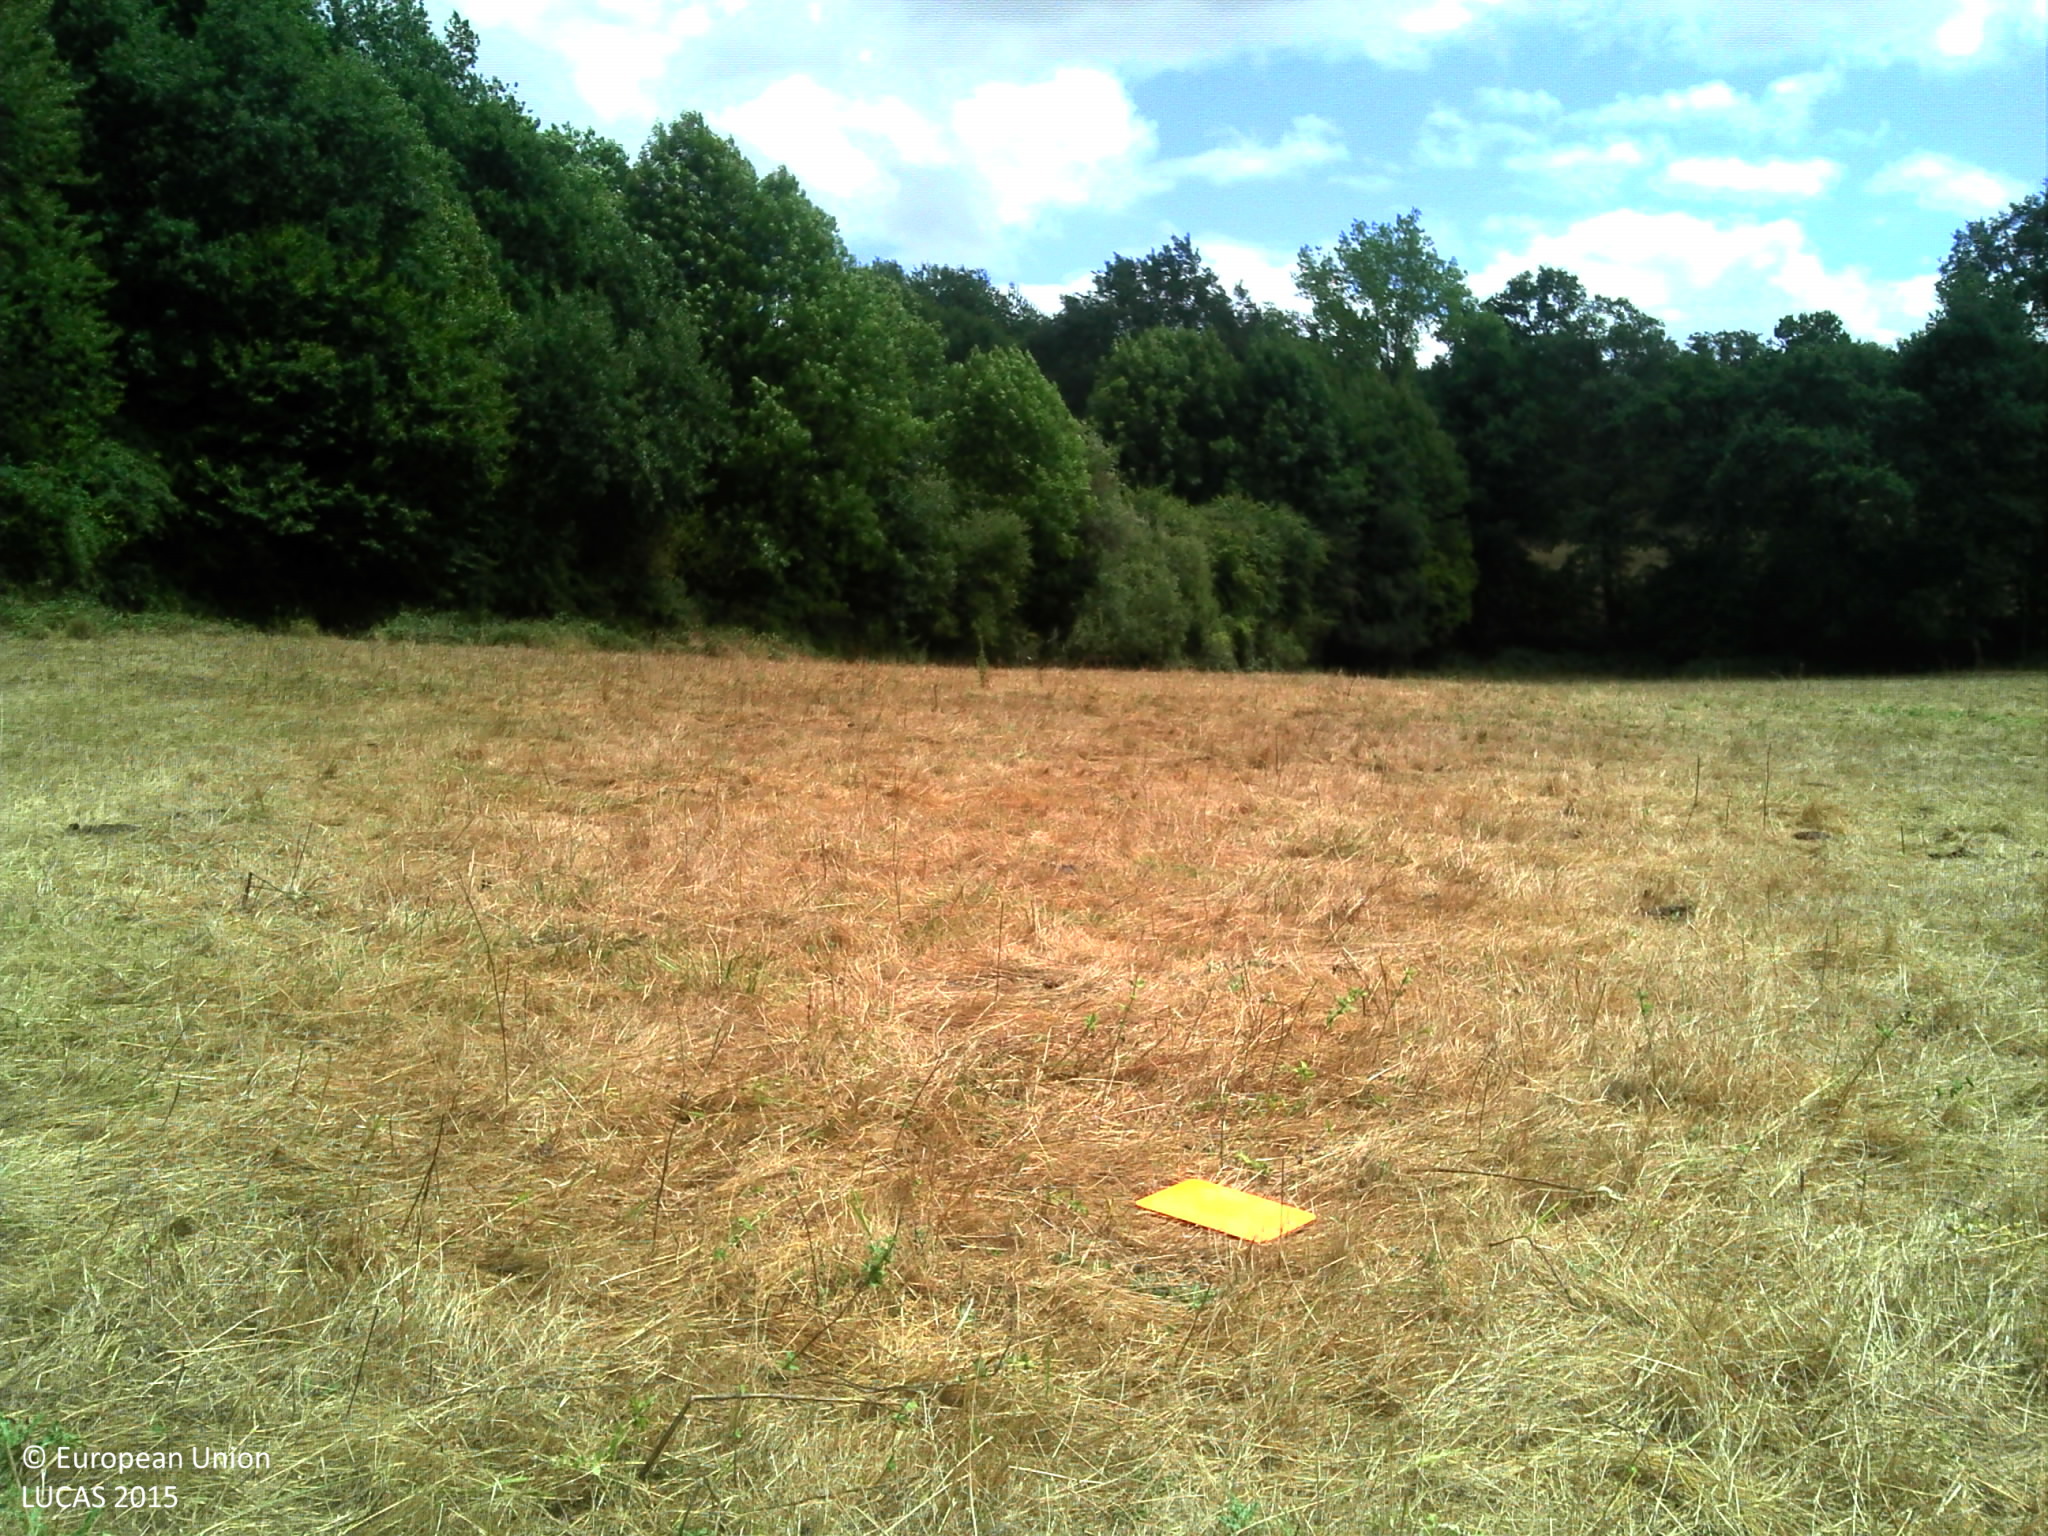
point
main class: Grassland
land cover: Grassland without tree/shrub cover
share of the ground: > 75 %
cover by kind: herbaceous plants 95 %, unconsolidated bare surface 5 %
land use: Agriculture (excluding fallow land and kitchen gardens)
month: July
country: FR
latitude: 45.4420
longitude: 1.3893
